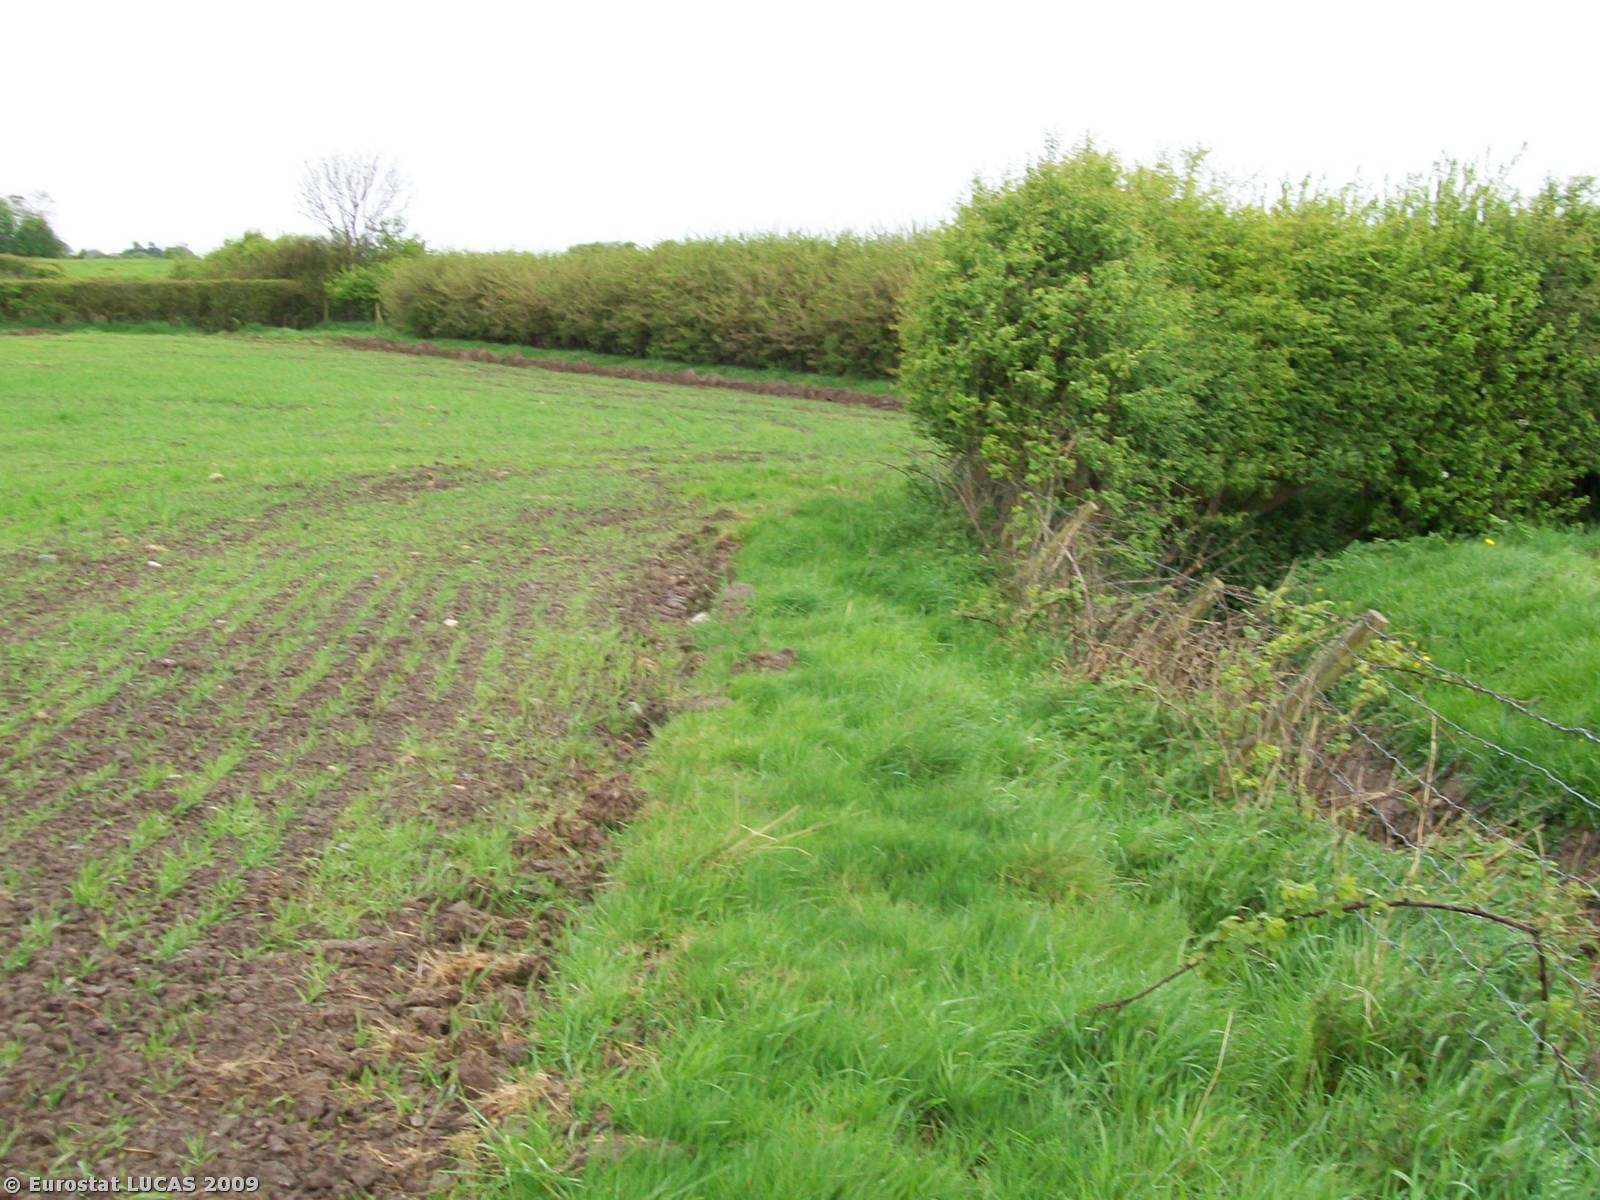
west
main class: Cropland
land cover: Barley
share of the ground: < 10 %
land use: Agriculture (excluding fallow land and kitchen gardens)
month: May
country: GB
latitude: 53.7660
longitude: -2.8910
